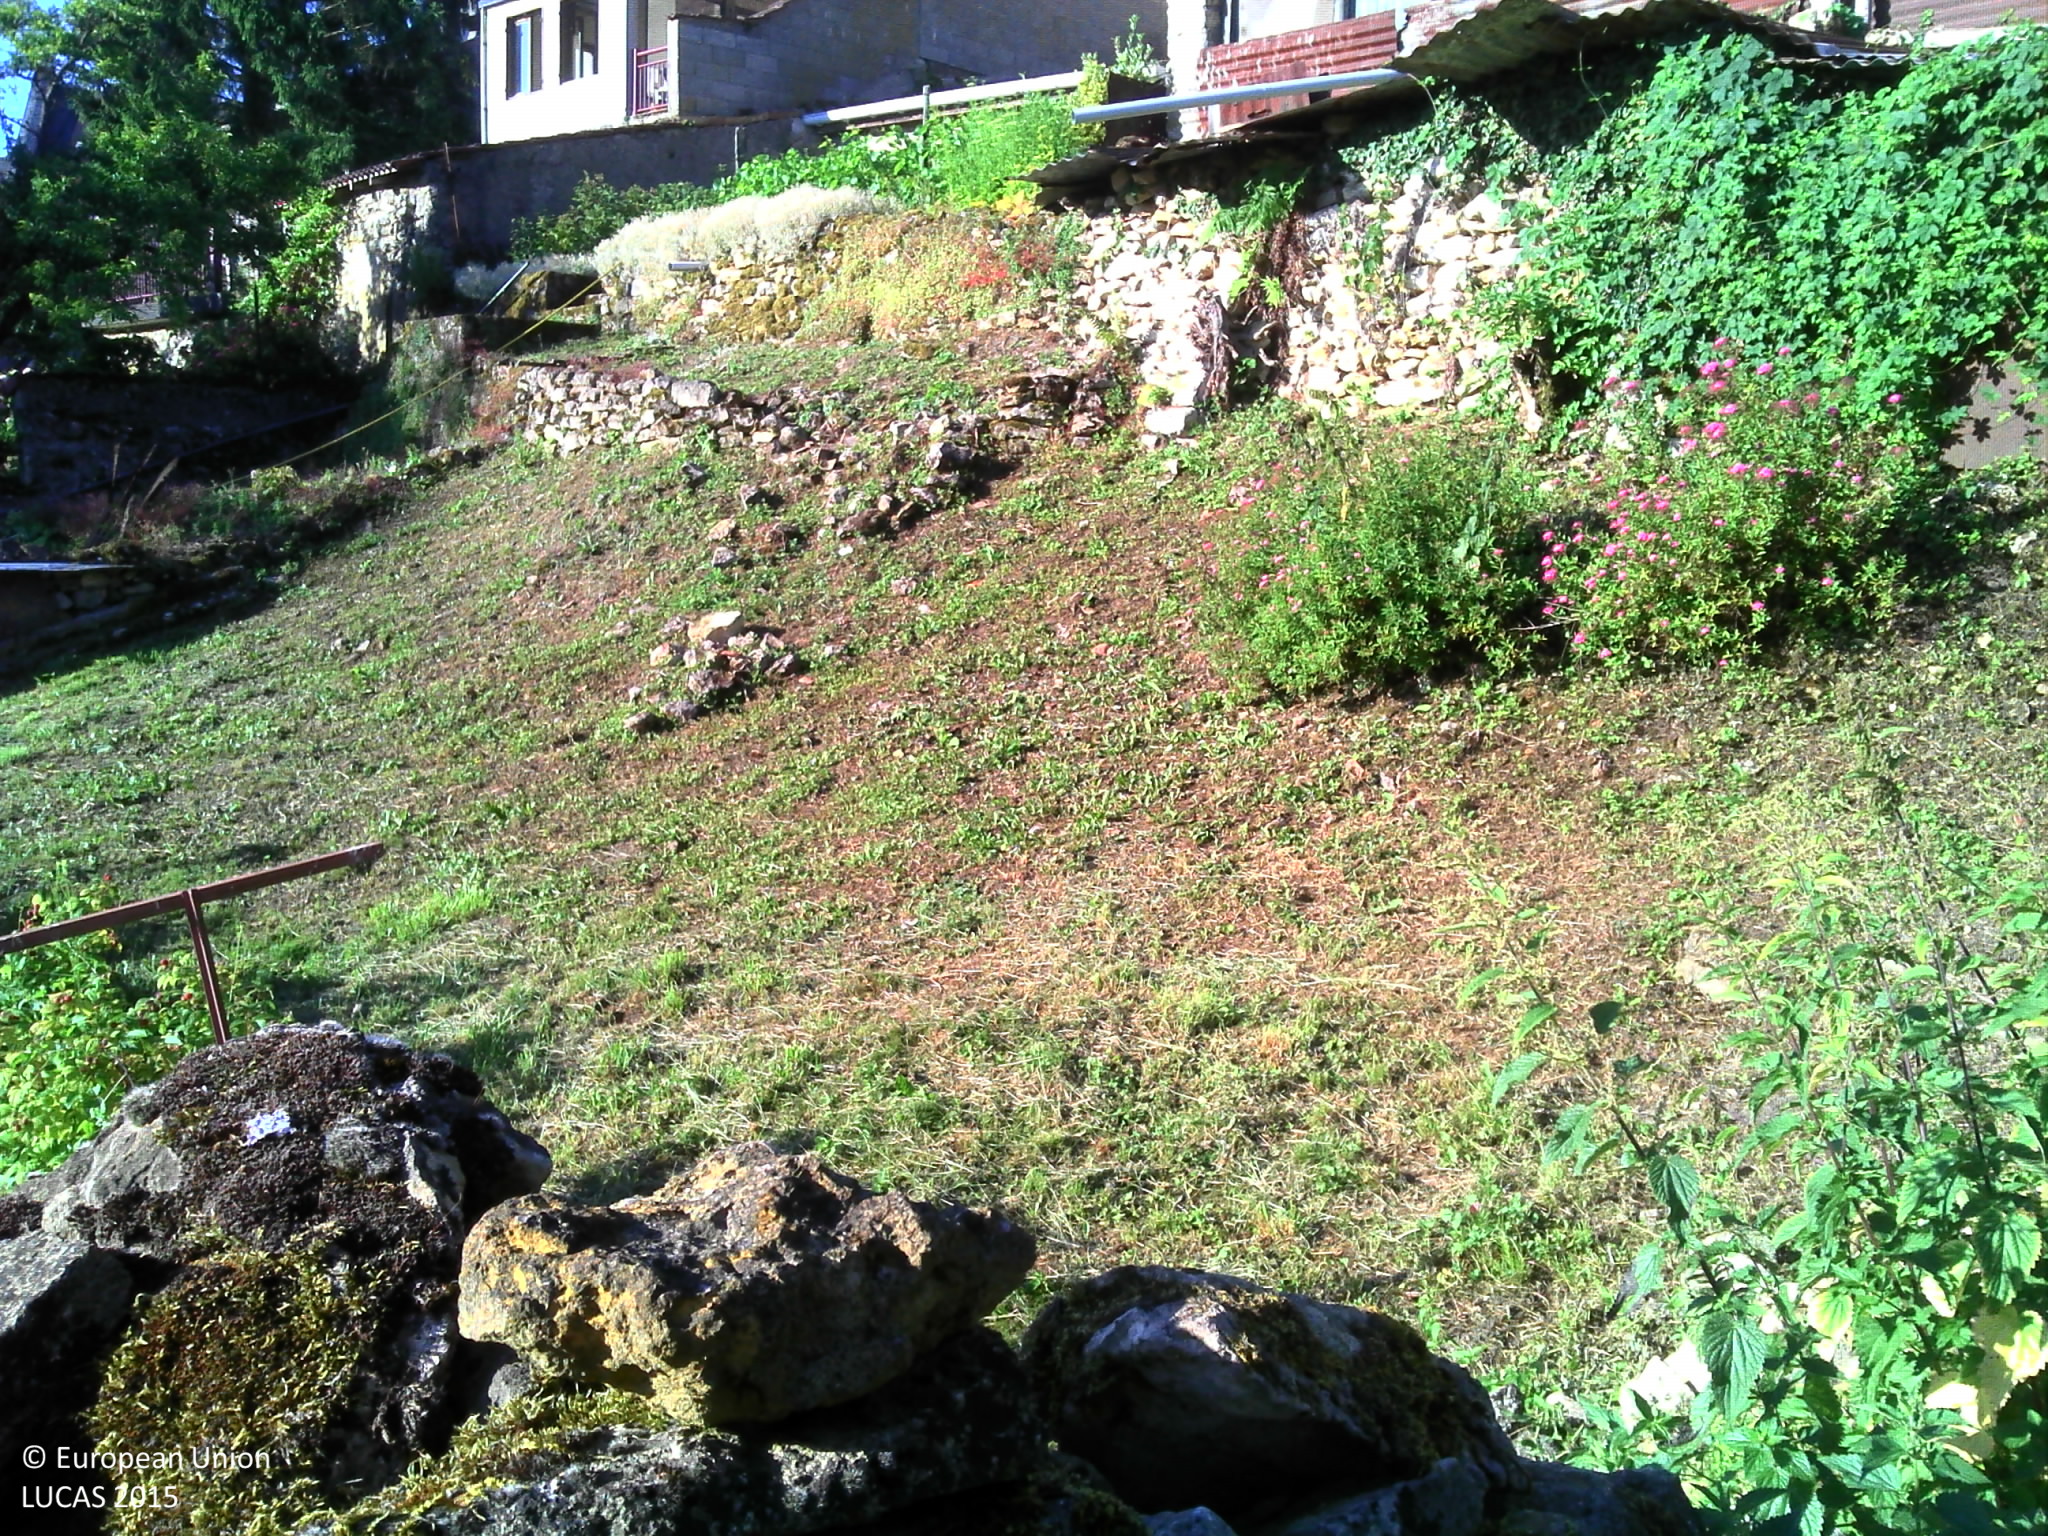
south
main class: Cropland
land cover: Cherry fruit
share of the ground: 50 - 75 %
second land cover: Other fruit trees and berries
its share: 50 - 75 %
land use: Kitchen garden
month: June
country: FR
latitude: 48.9795
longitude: 5.9963
